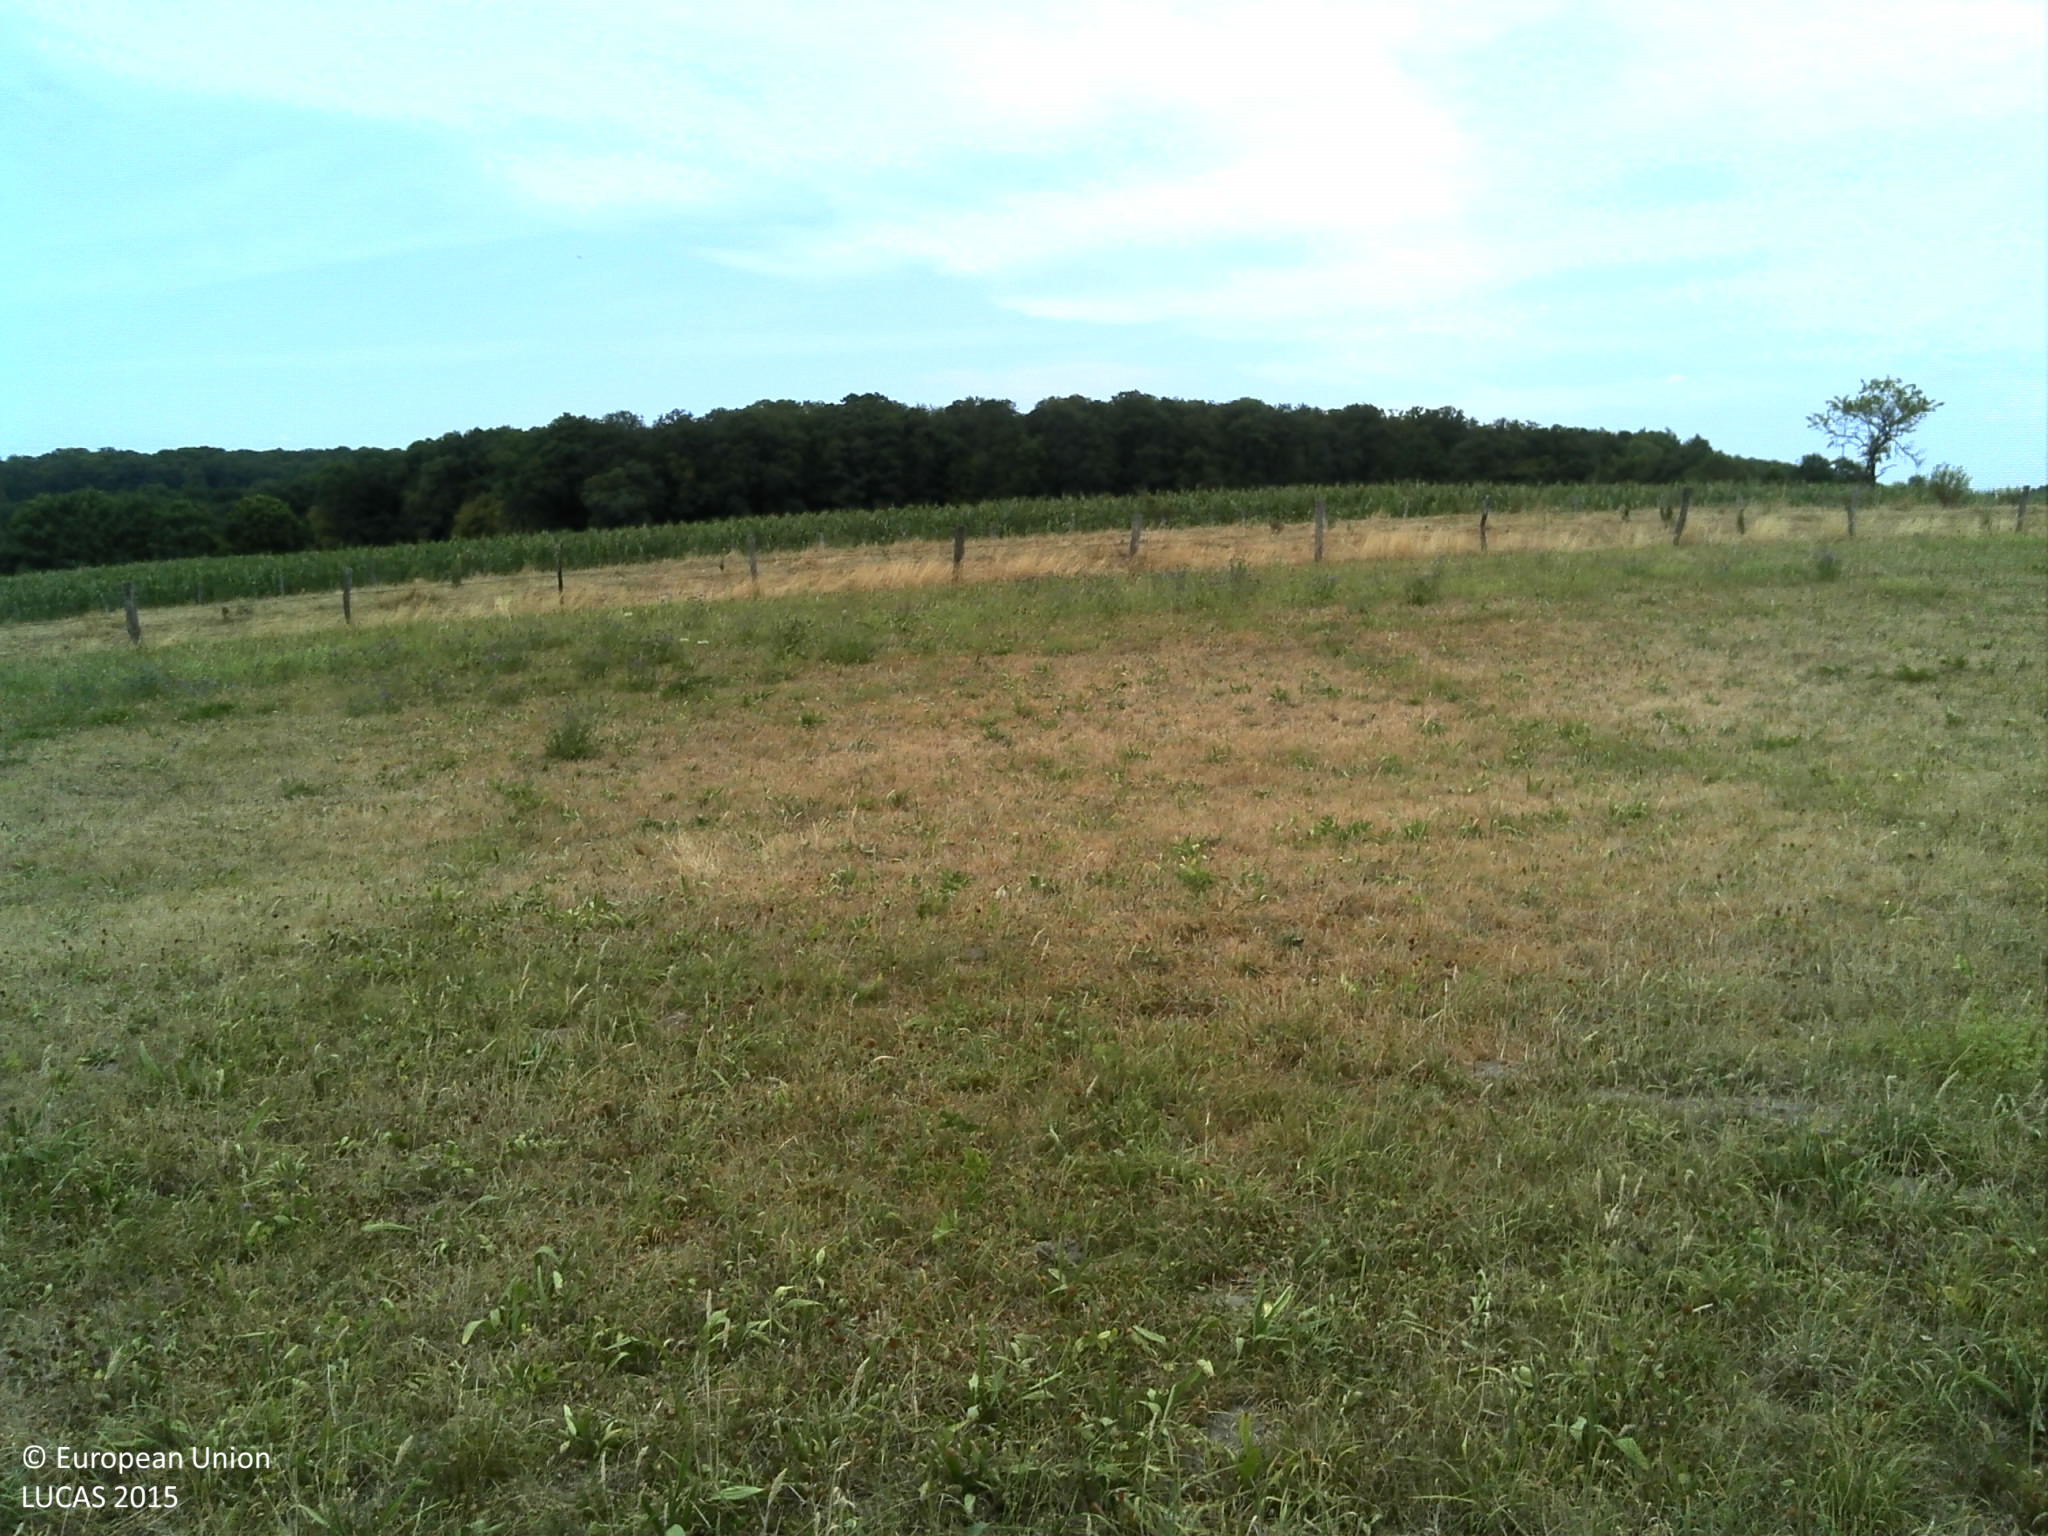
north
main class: Grassland
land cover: Grassland without tree/shrub cover
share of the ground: > 75 %
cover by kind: herbaceous plants 100 %
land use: Agriculture (excluding fallow land and kitchen gardens)
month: July
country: FR
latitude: 48.2856
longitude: 6.2404
